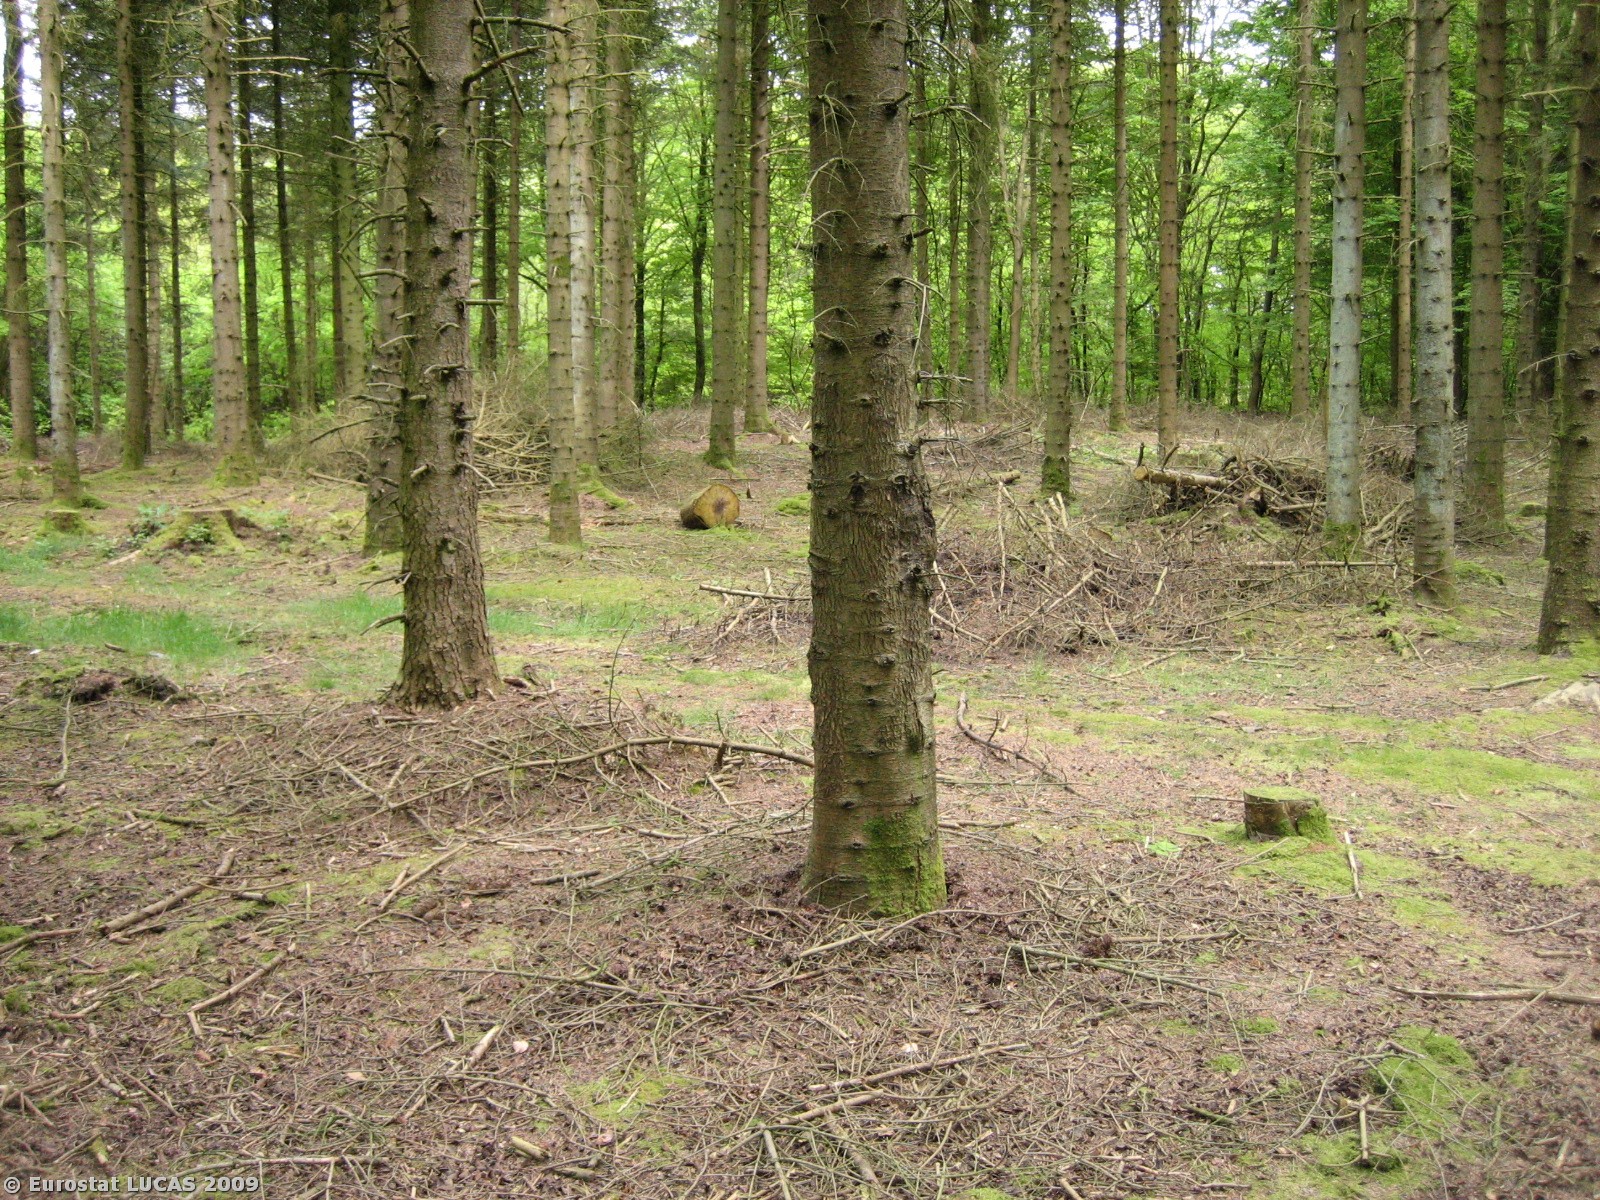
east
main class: Woodland
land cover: Coniferous woodland
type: hemiboreal forest and nemoral coniferous forest and mixed broadleaved-coniferous forest
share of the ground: > 75 %
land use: Forestry
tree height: > 5 m
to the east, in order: Coniferous woodland; Tracks; Coniferous woodland; Tracks; Broadleaved woodland; Tracks; Broadleaved woodland; Paved roads, cycling and walking lanes; Mixed woodland; Coniferous woodland
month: May
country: DK
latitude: 56.1599
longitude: 8.4077
